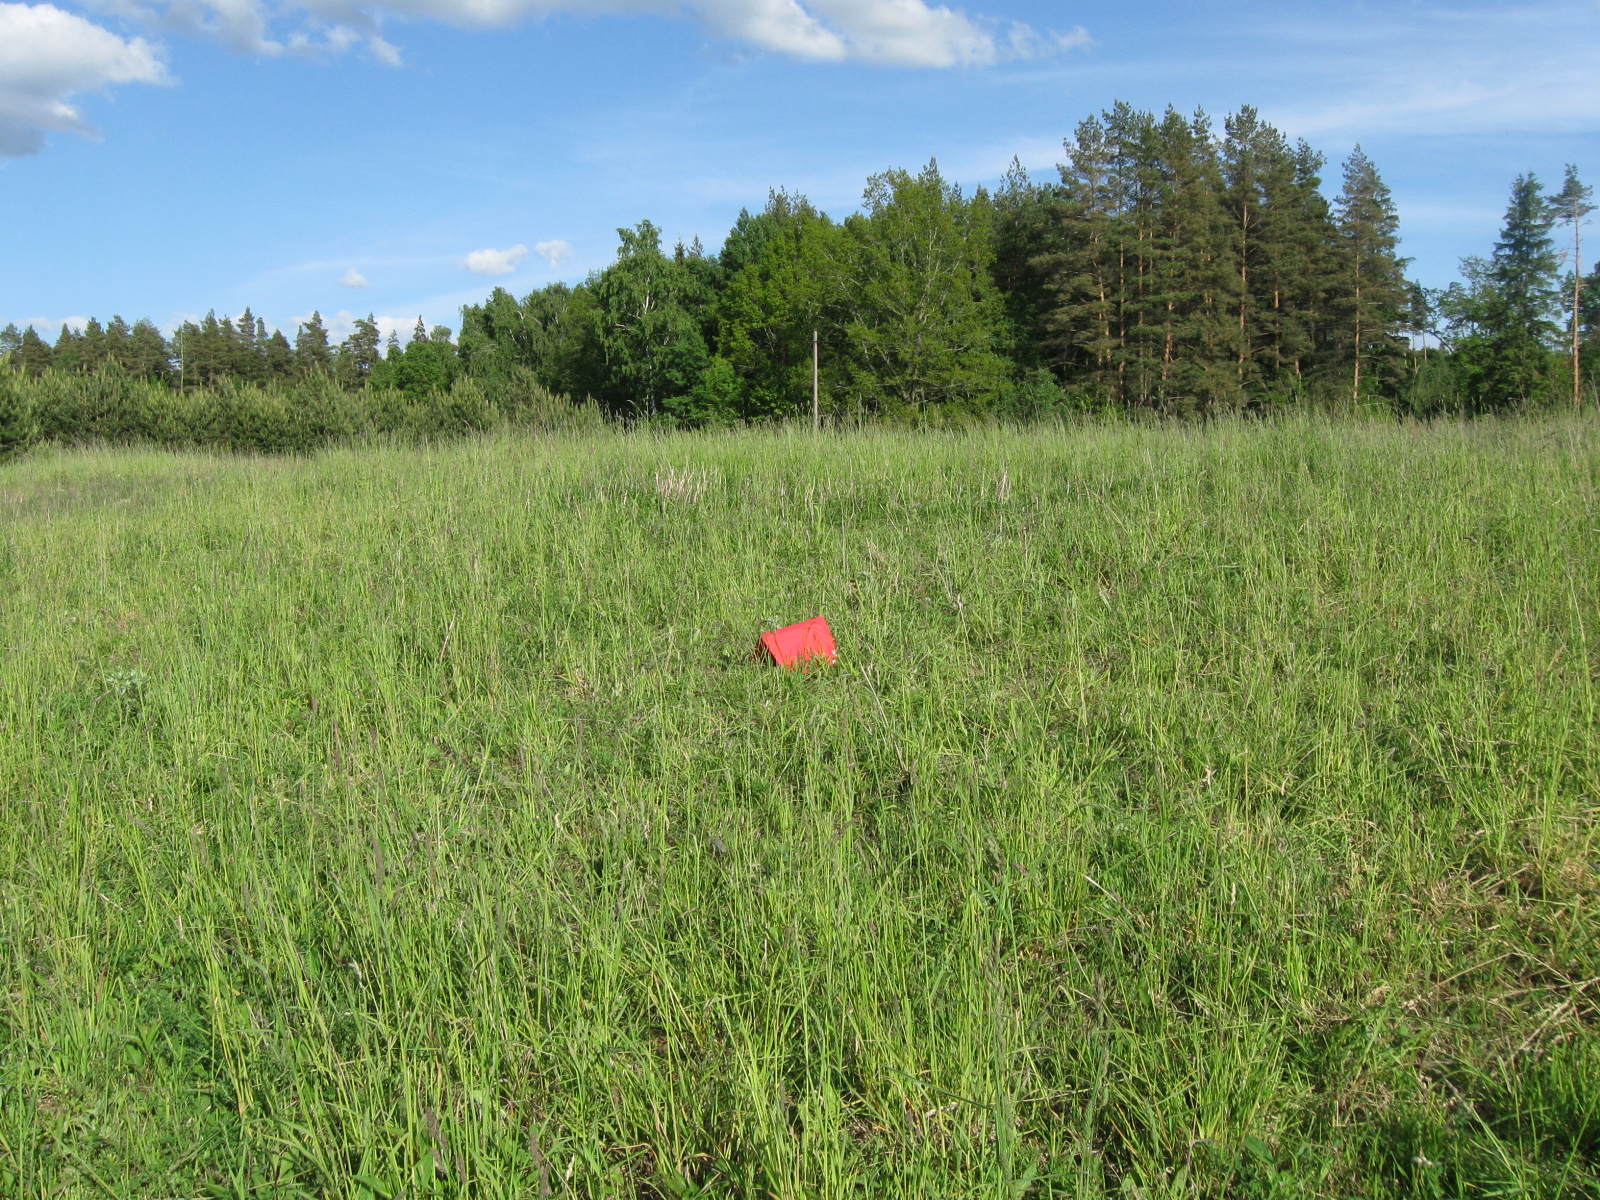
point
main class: Grassland
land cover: Grassland without tree/shrub cover
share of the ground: > 75 %
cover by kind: herbaceous plants 95 %, unconsolidated bare surface 5 %
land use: Agriculture (excluding fallow land and kitchen gardens)
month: May
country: LT
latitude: 54.2943
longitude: 23.4013
